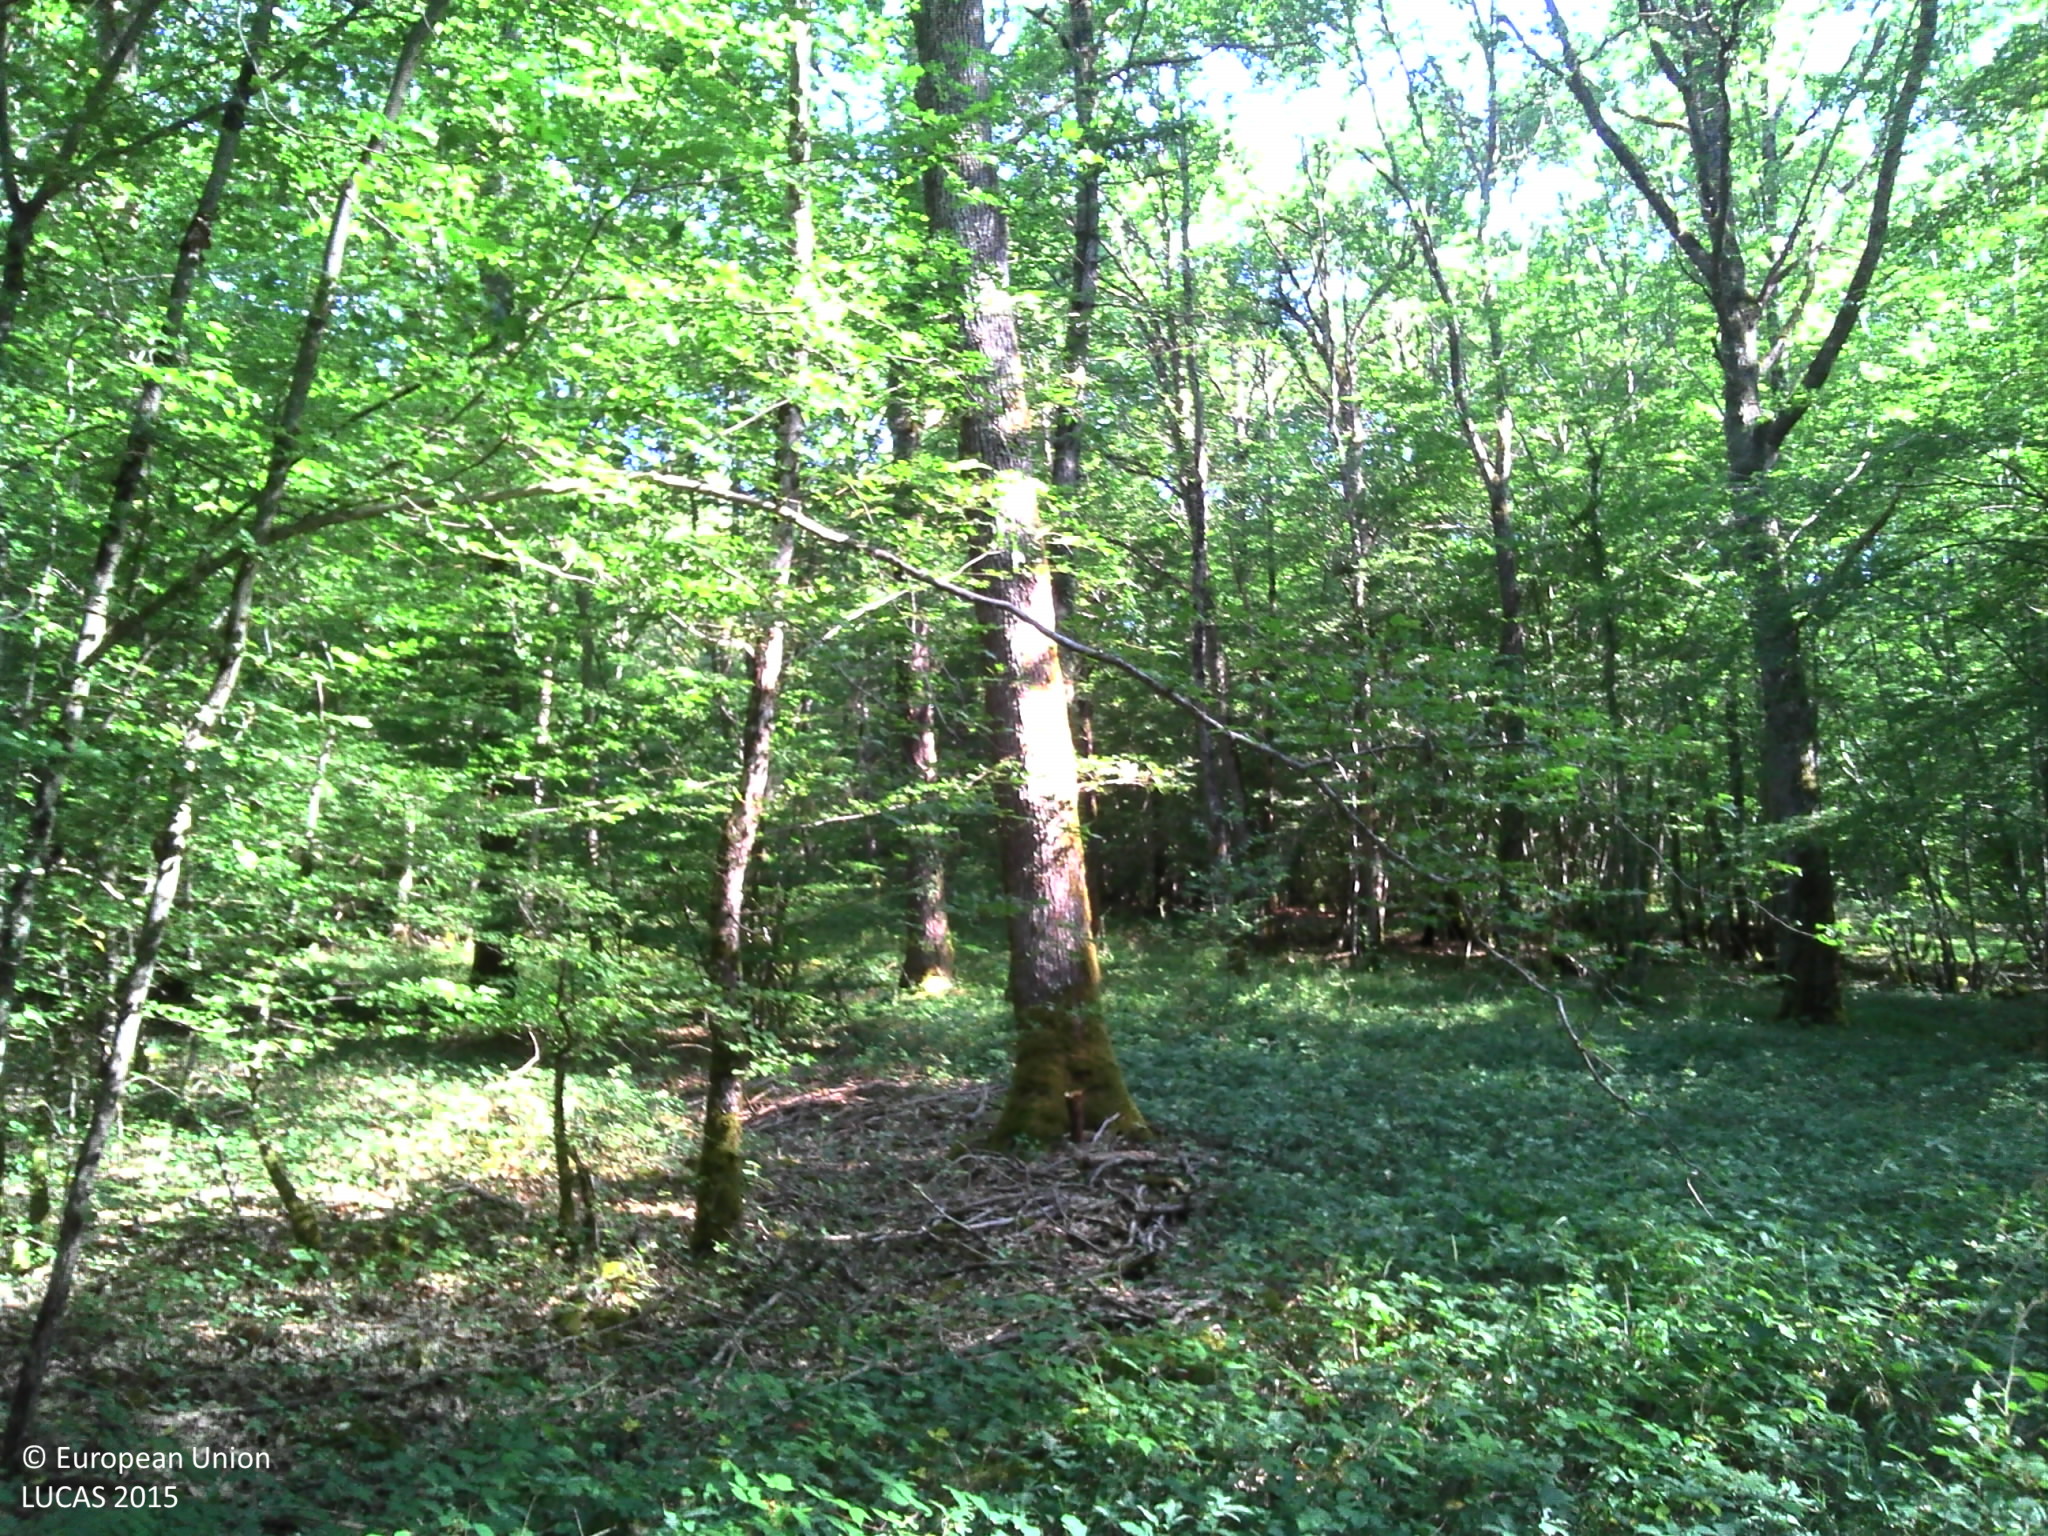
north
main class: Woodland
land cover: Broadleaved woodland
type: mesophytic deciduous forest
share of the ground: > 75 %
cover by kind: broadleaved forest trees 90 %, unconsolidated bare surface 10 %
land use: Forestry
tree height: > 5 m
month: July
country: FR
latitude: 46.8287
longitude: 3.6141
